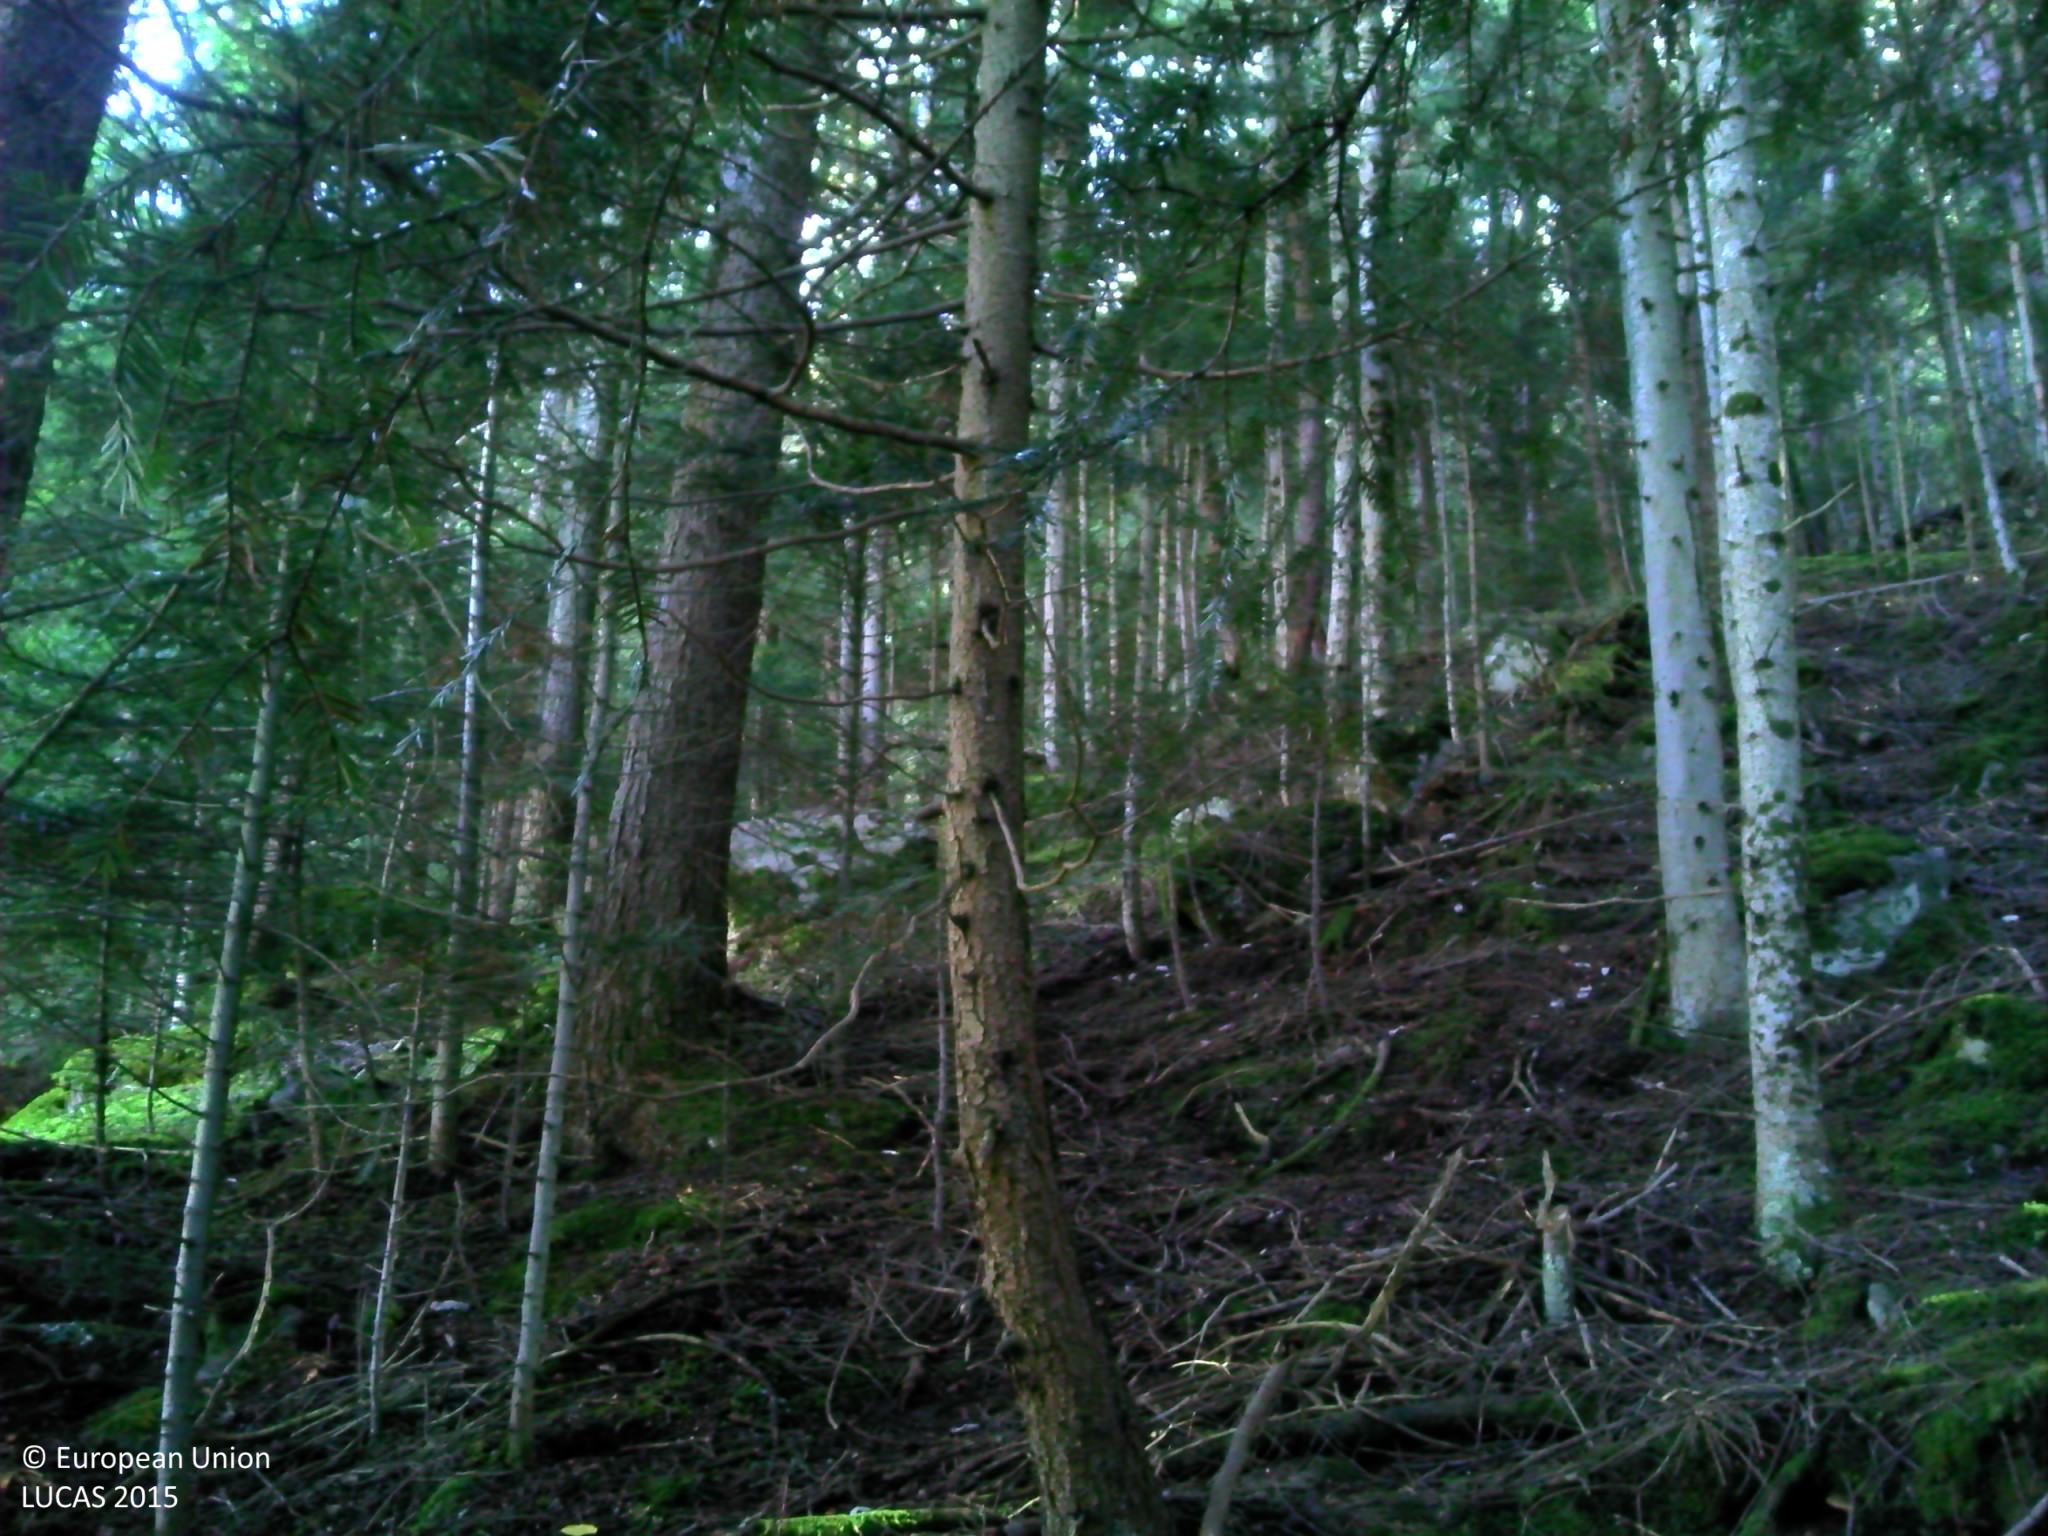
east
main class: Woodland
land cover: Spruce dominated coniferous woodland
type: alpine coniferous forest
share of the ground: > 75 %
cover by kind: coniferous forest trees 95 %, consolidated bare surface 5 %
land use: Forestry
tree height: > 5 m
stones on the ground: < 10 %
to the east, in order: Spruce dominated coniferous woodland; Tracks; Spruce dominated coniferous woodland; Tracks; Grassland with sparse tree/shrub cover; Spruce dominated coniferous woodland
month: October
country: FR
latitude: 45.3337
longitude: 6.3683
